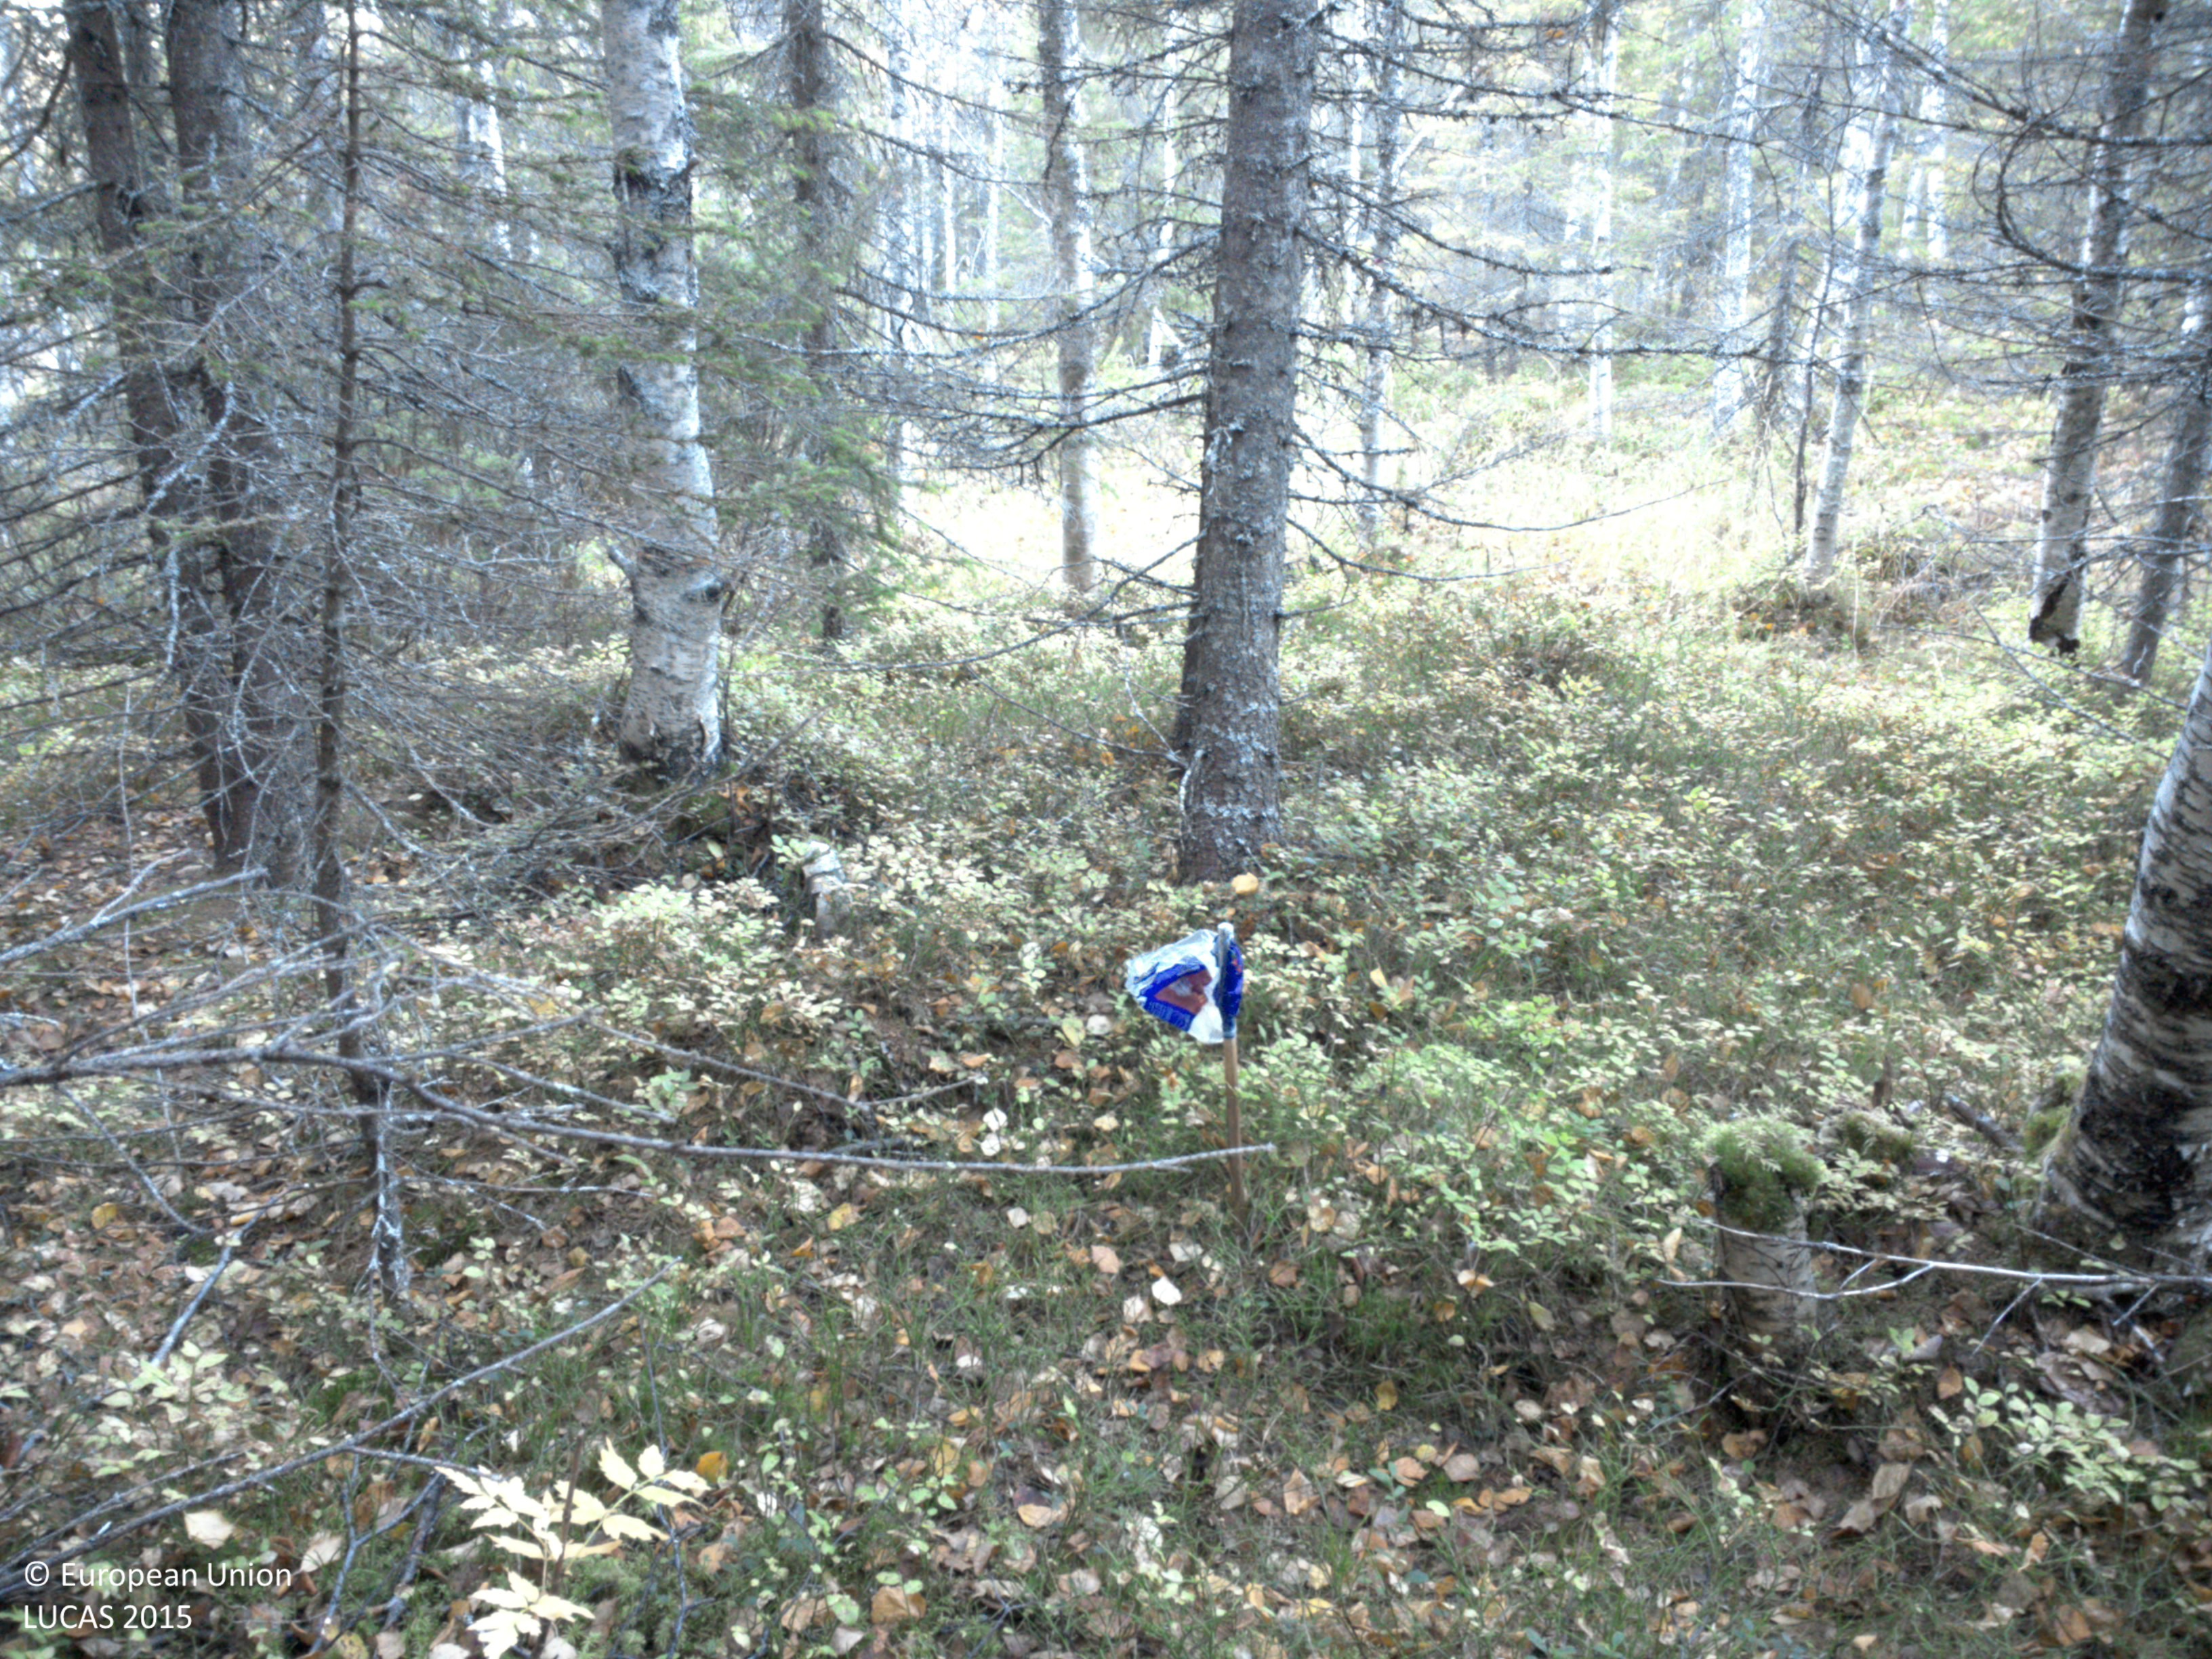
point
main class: Woodland
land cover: Spruce dominated mixed woodland
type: boreal forest
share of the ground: 50 - 75 %
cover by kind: coniferous forest trees 45 %, shrubs 30 %, broadleaved forest trees 15 %, herbaceous plants 10 %
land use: Forestry
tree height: > 5 m
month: October
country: SE
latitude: 64.6594
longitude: 17.8188
